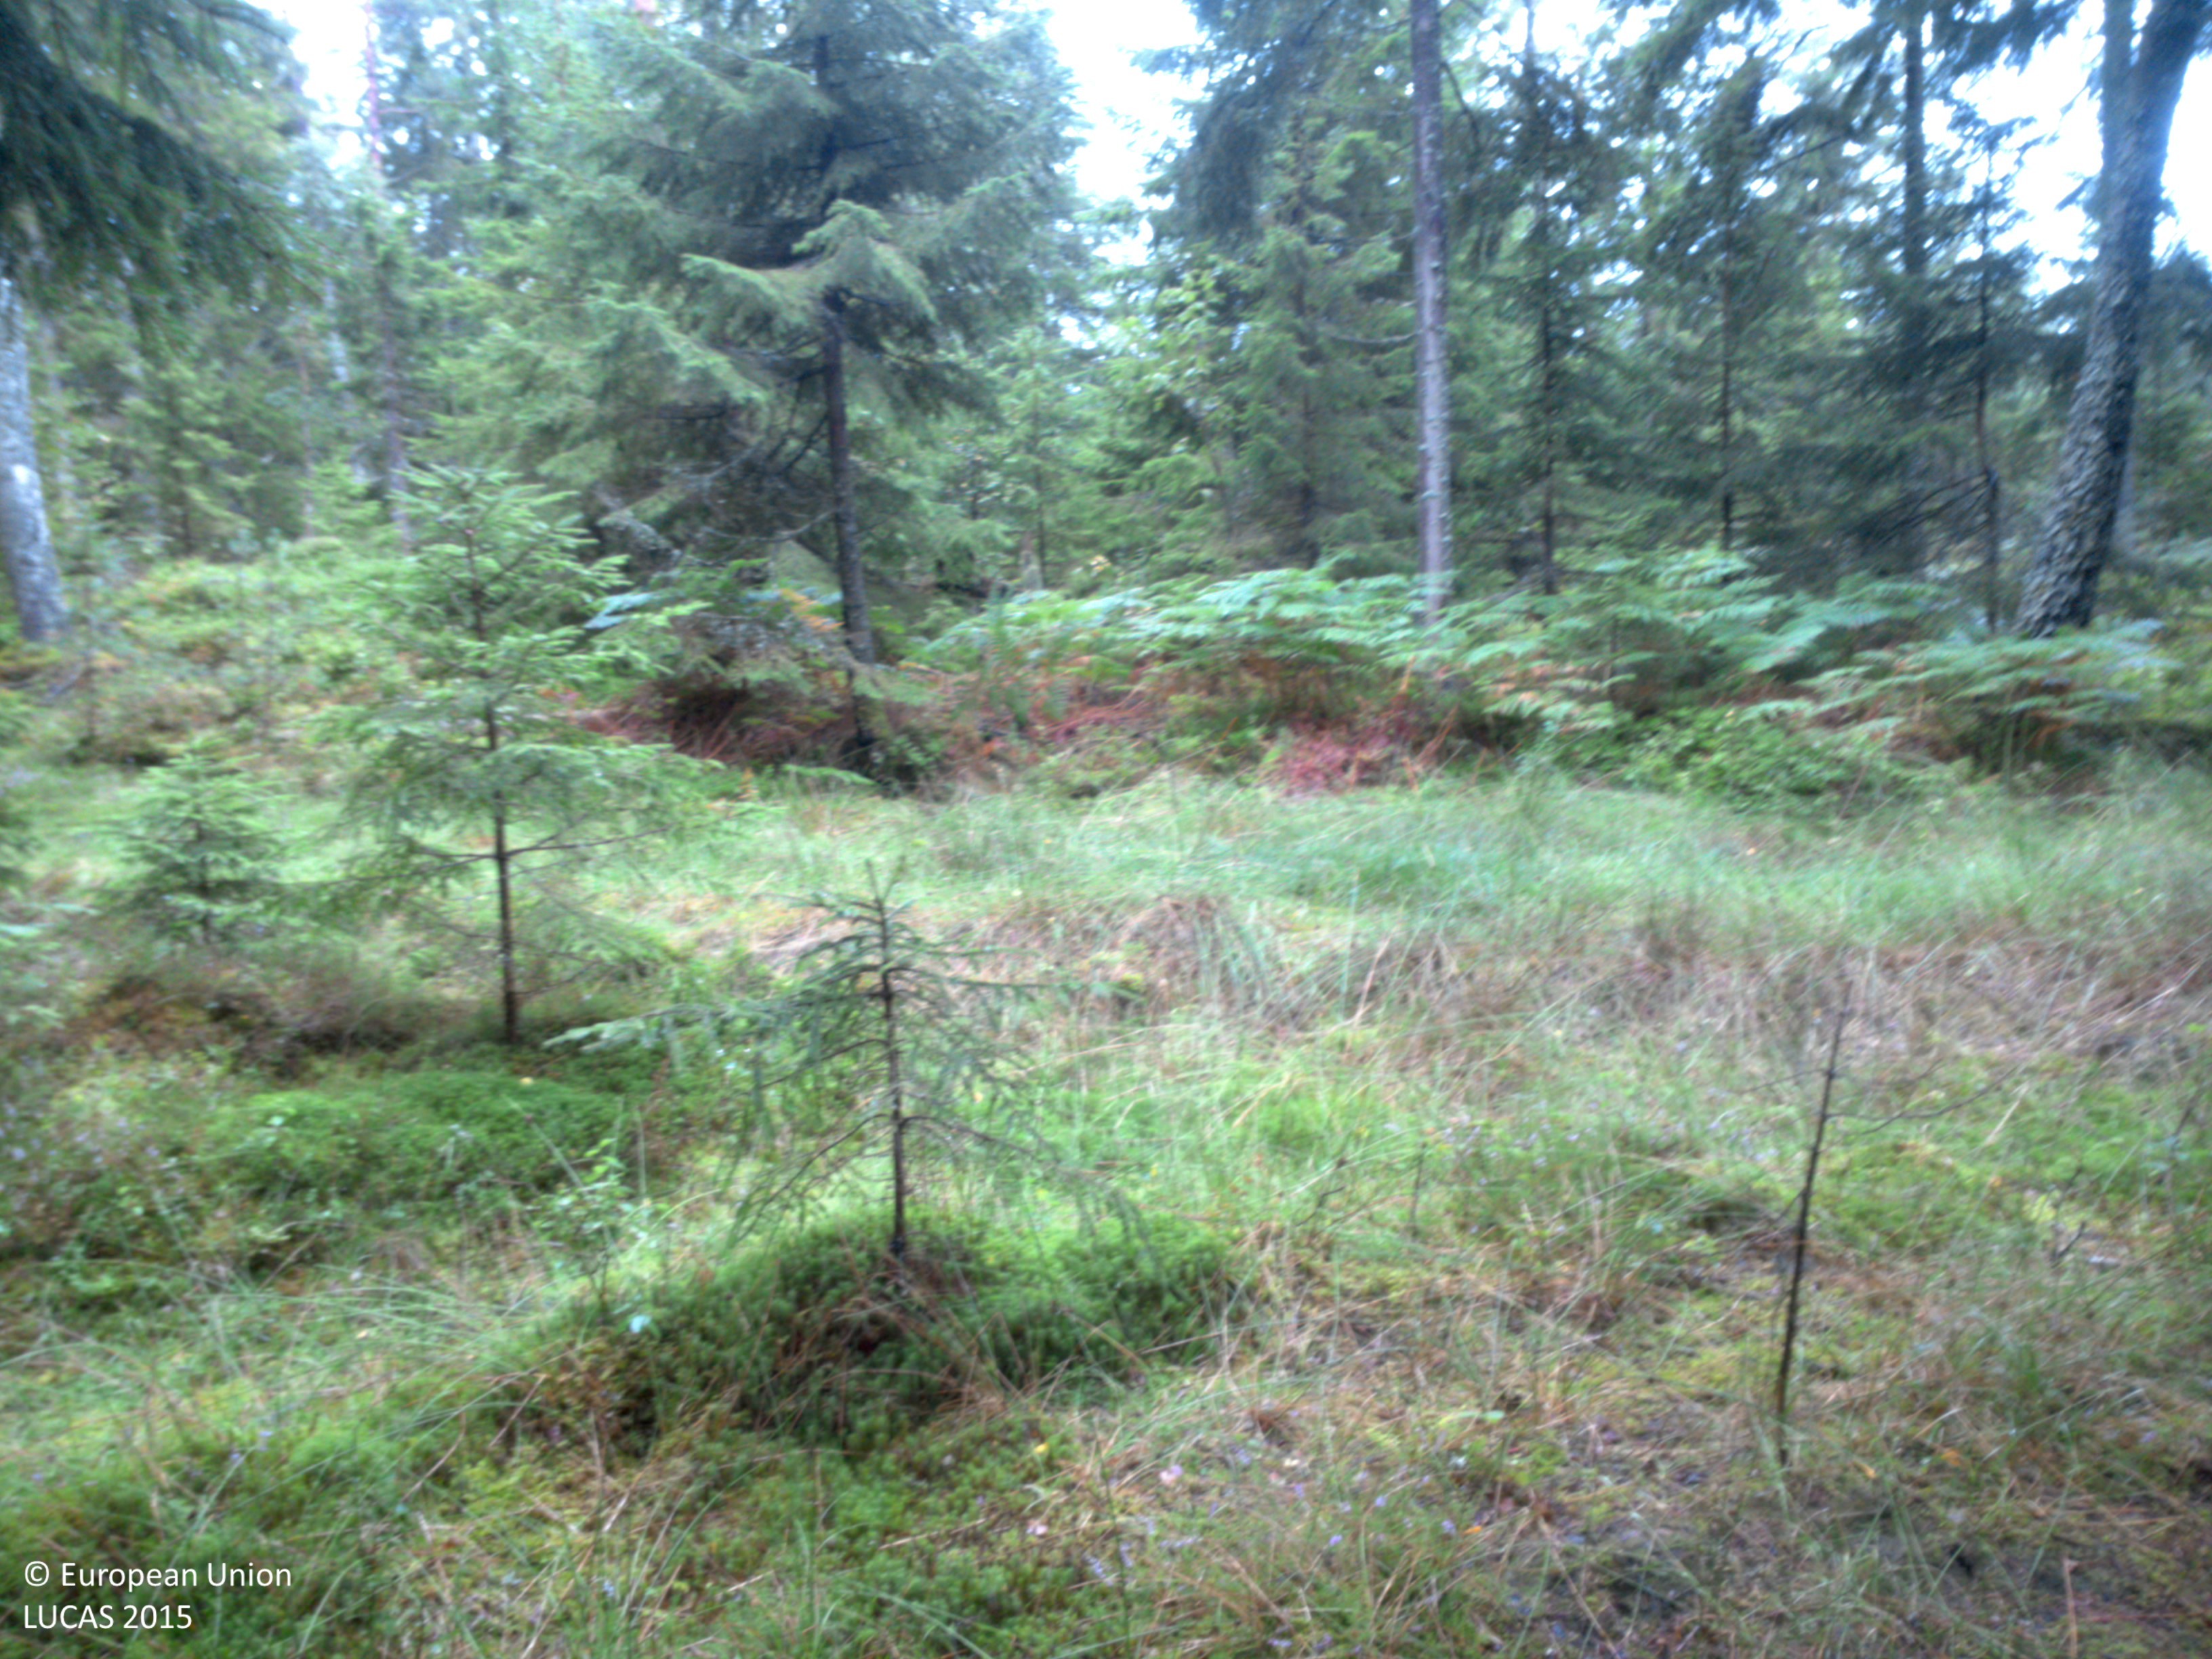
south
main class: Woodland
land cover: Spruce dominated coniferous woodland
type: boreal forest
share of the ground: 50 - 75 %
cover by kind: coniferous forest trees 70 %, lichens and mosses 30 %
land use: Forestry
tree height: > 5 m
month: August
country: SE
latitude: 58.0921
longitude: 12.2858
